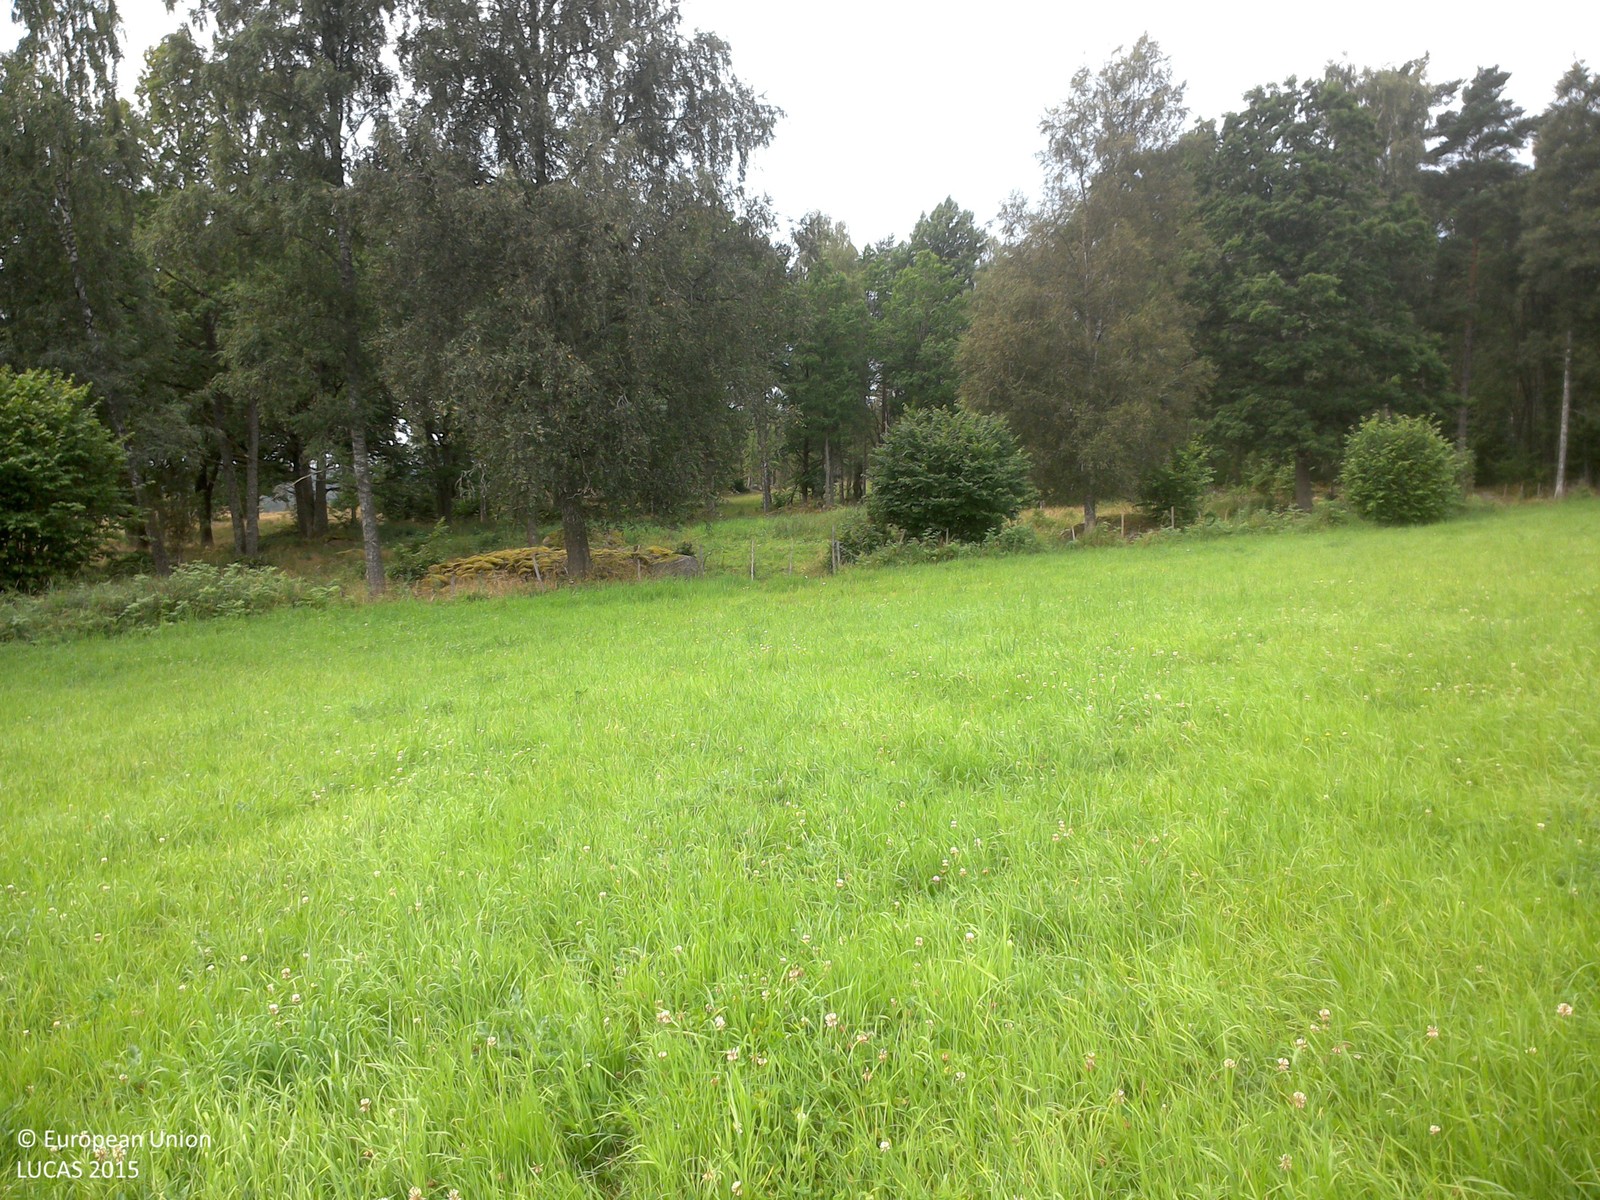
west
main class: Cropland
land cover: Other leguminous and mixtures for fodder
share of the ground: > 75 %
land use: Agriculture (excluding fallow land and kitchen gardens)
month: August
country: SE
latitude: 57.7330
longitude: 15.3870
